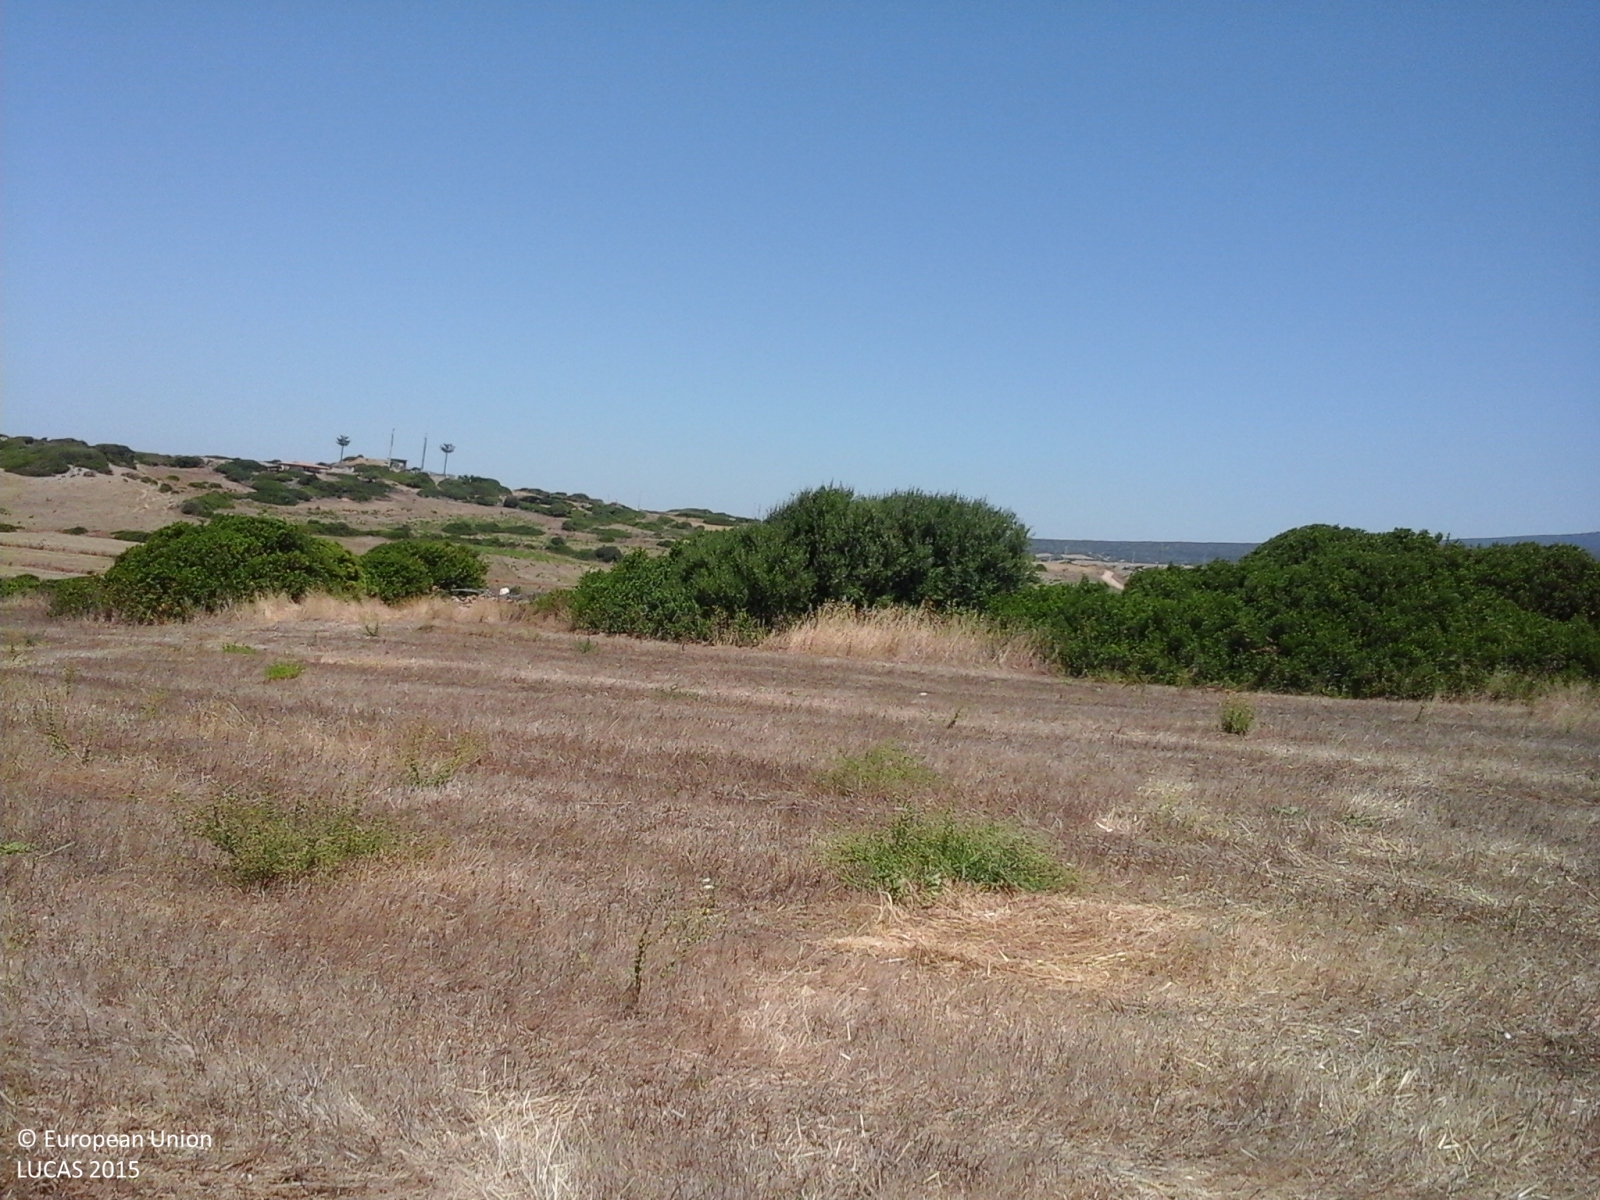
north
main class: Grassland
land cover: Grassland without tree/shrub cover
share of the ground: > 75 %
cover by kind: herbaceous plants 100 %
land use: Agriculture (excluding fallow land and kitchen gardens)
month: August
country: IT
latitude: 40.0928
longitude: 8.4950
